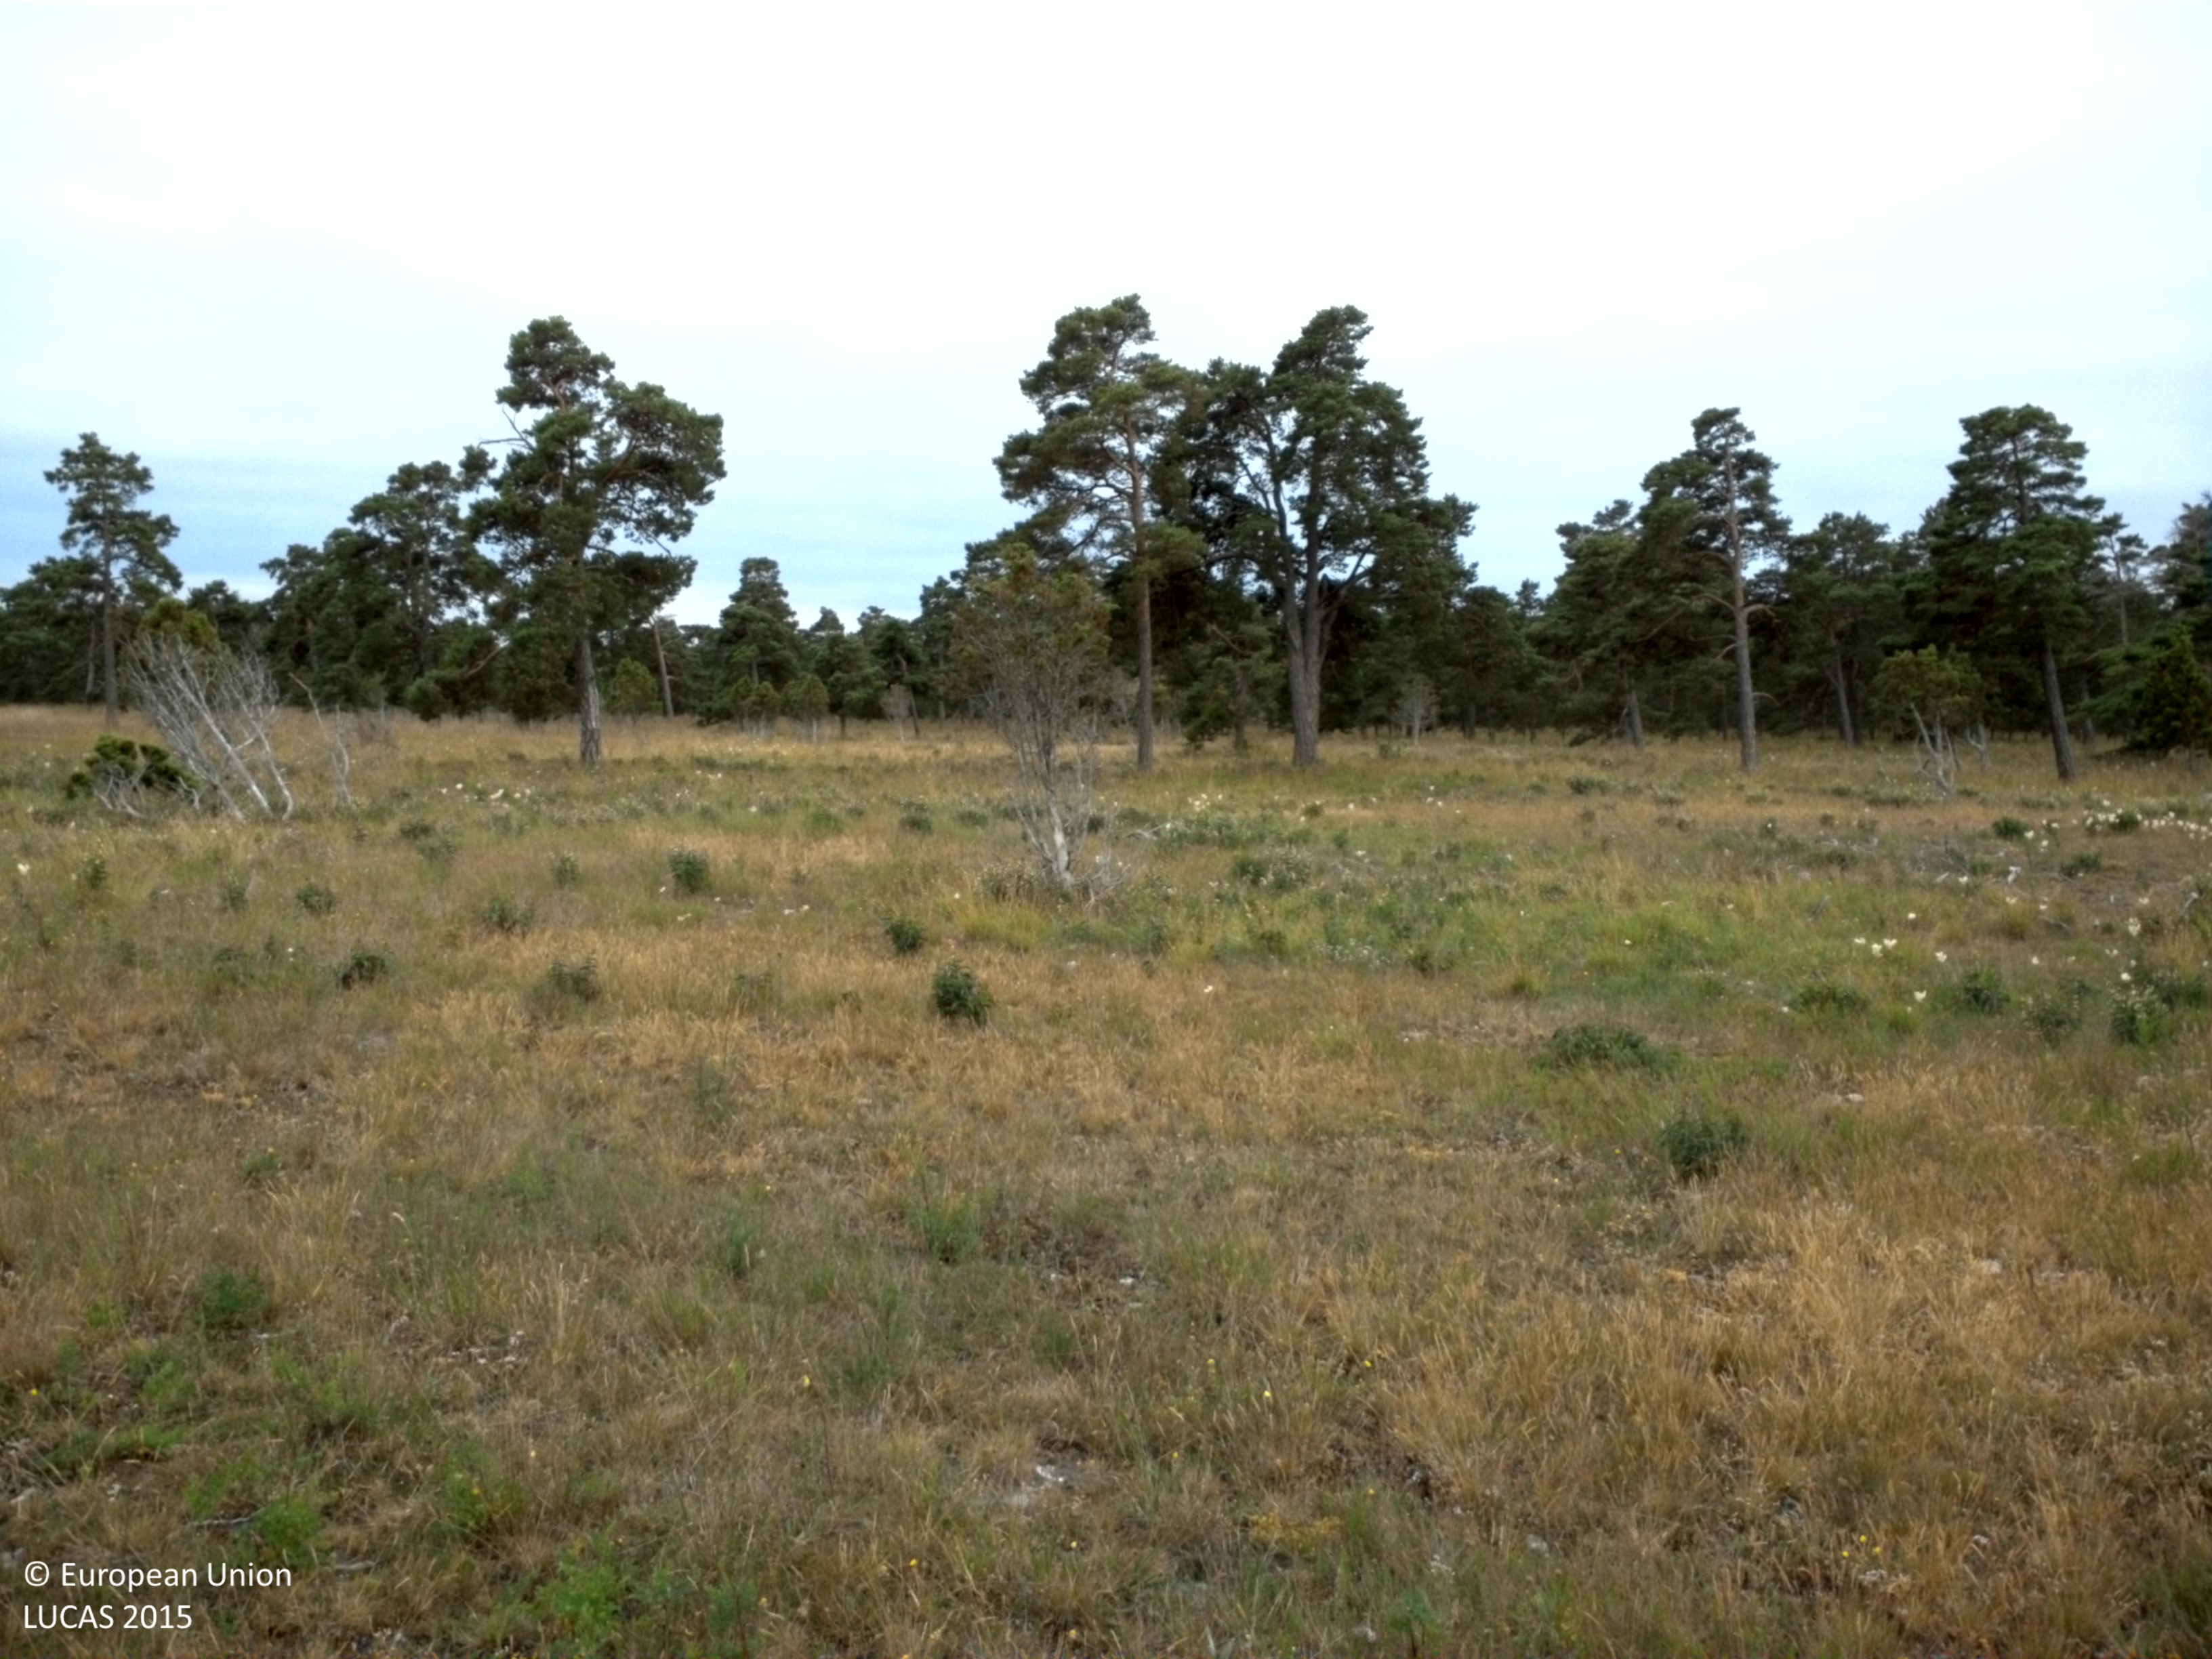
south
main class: Grassland
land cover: Grassland with sparse tree/shrub cover
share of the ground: > 75 %
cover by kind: herbaceous plants 85 %, coniferous forest trees 5 %, shrubs 5 %, lichens and mosses 5 %
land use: Agriculture (excluding fallow land and kitchen gardens)
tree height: > 5 m
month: June
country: SE
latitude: 57.9056
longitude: 18.9029
